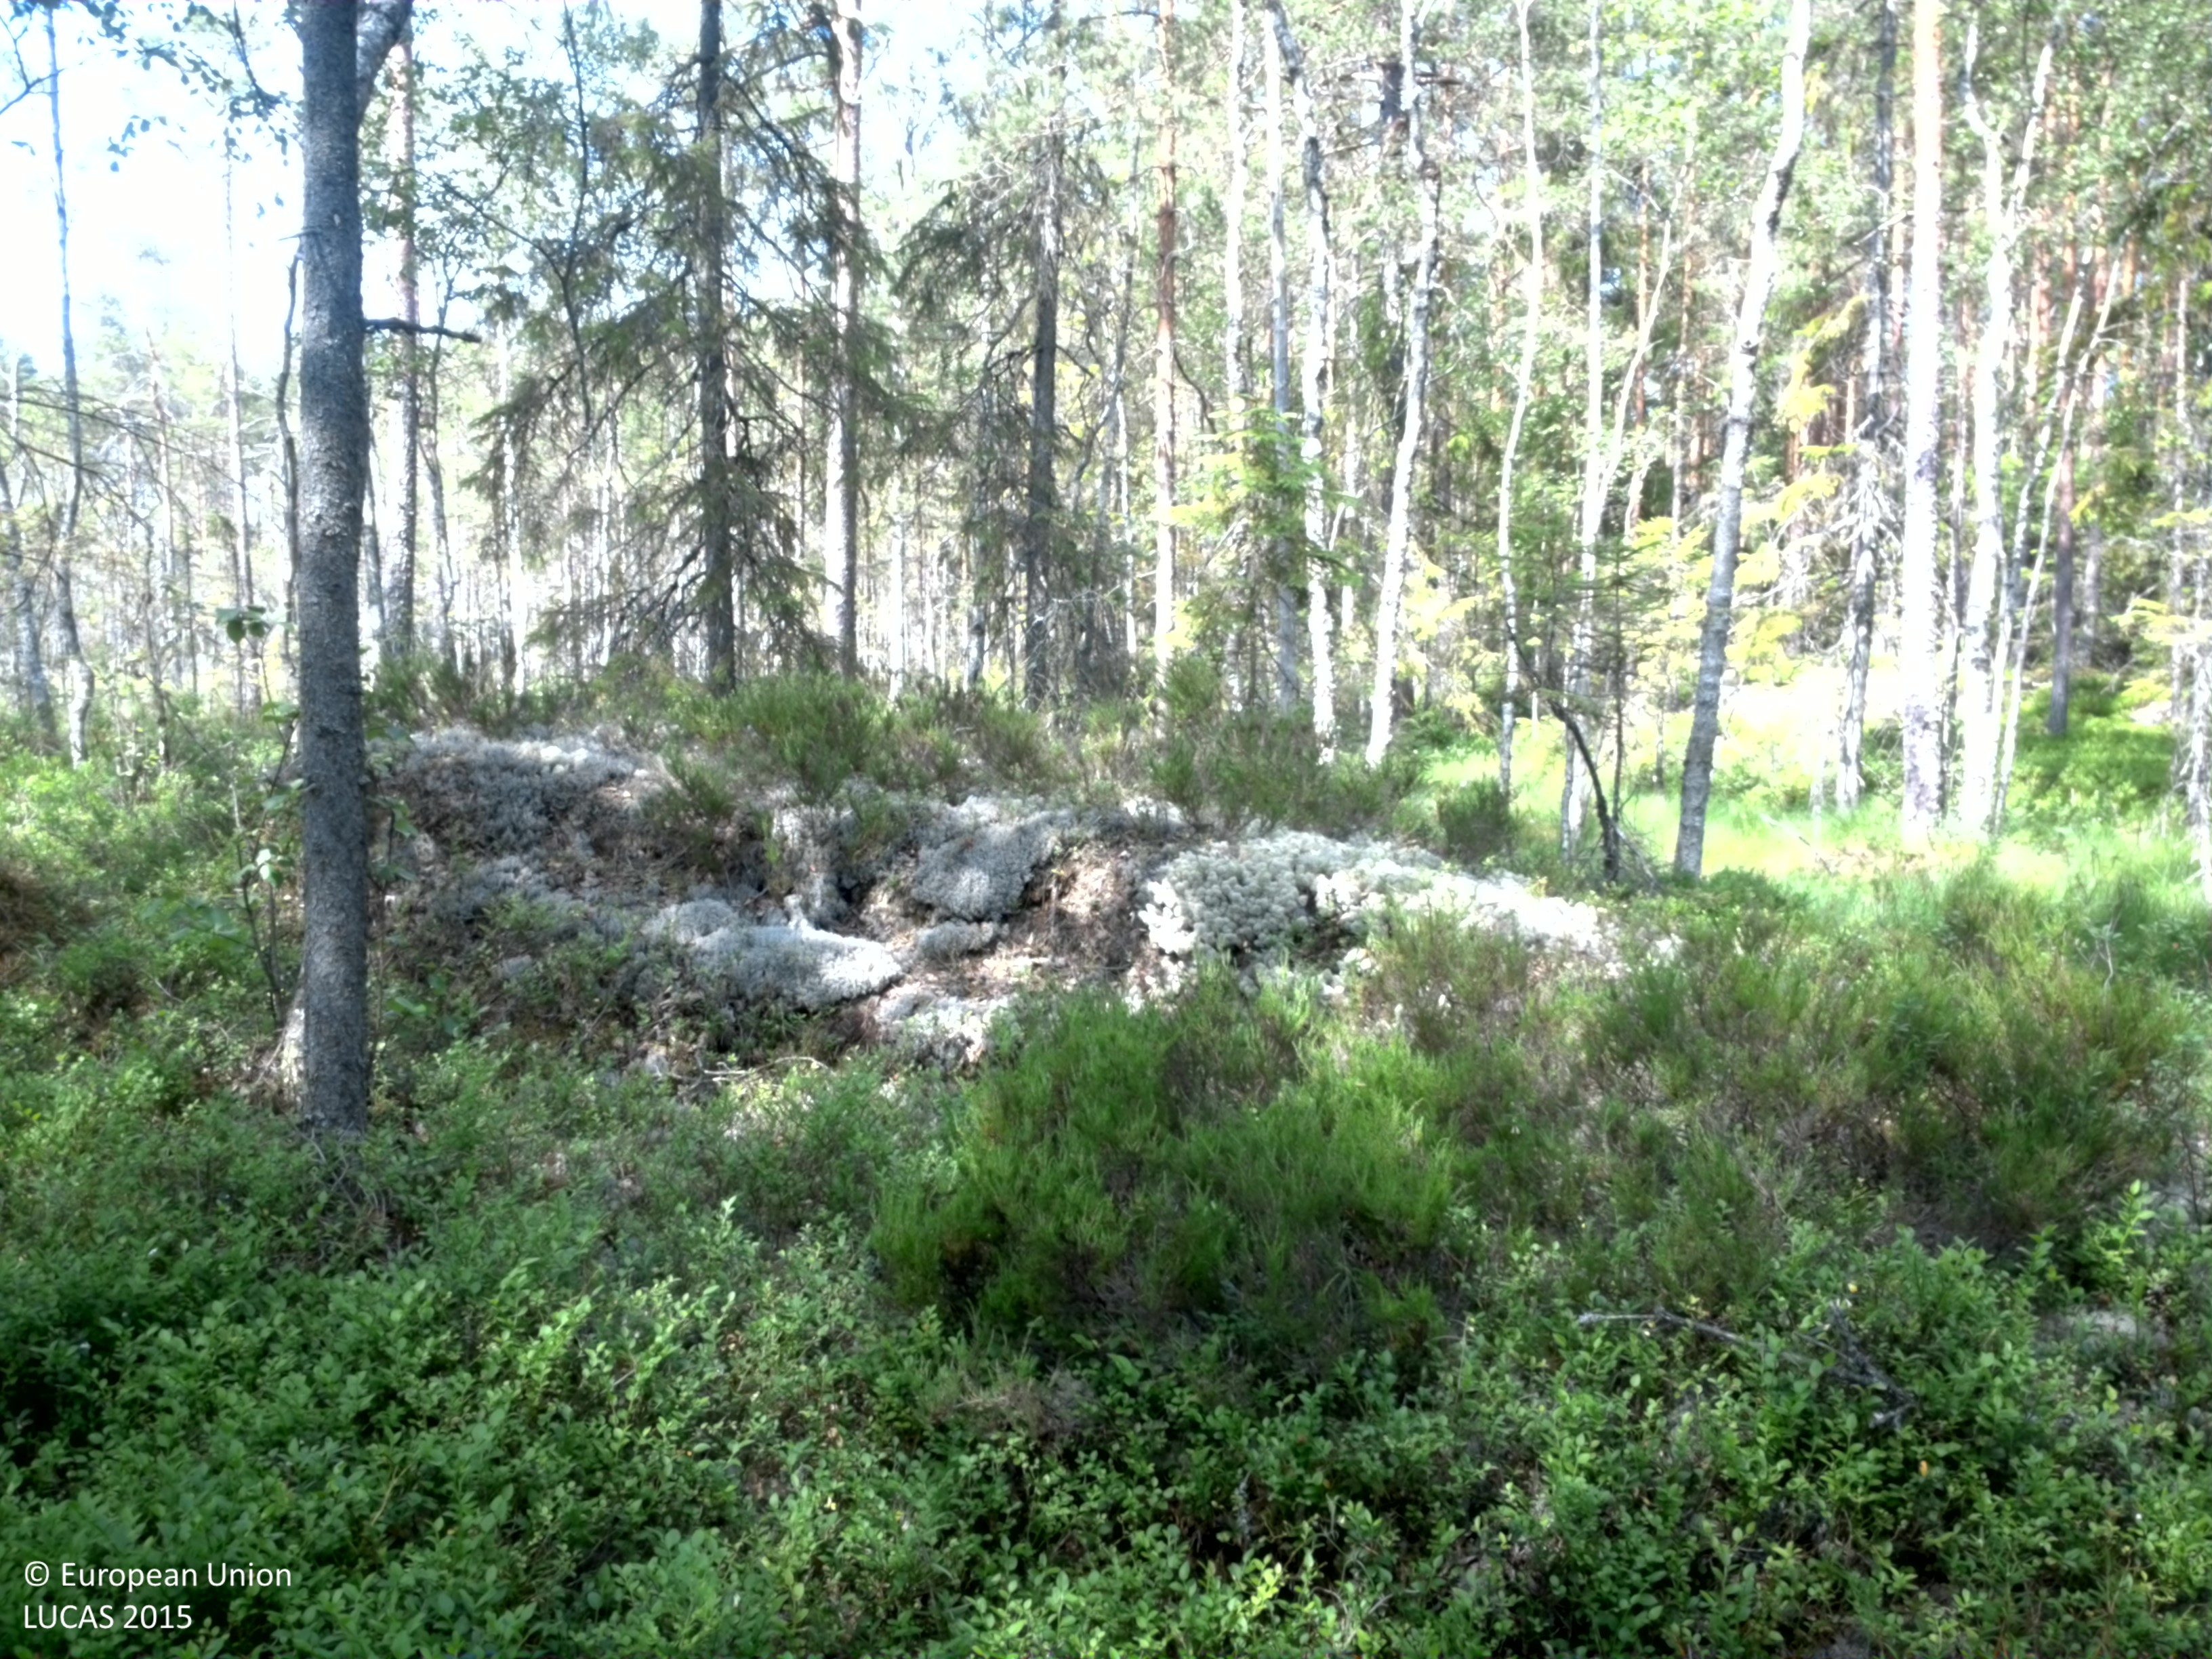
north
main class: Woodland
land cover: Pine dominated mixed woodland
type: boreal forest
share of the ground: 50 - 75 %
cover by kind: coniferous forest trees 50 %, broadleaved forest trees 20 %, shrubs 15 %, herbaceous plants 10 %, consolidated bare surface 5 %
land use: Forestry
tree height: > 5 m
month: July
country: SE
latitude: 59.2772
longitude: 14.5718
